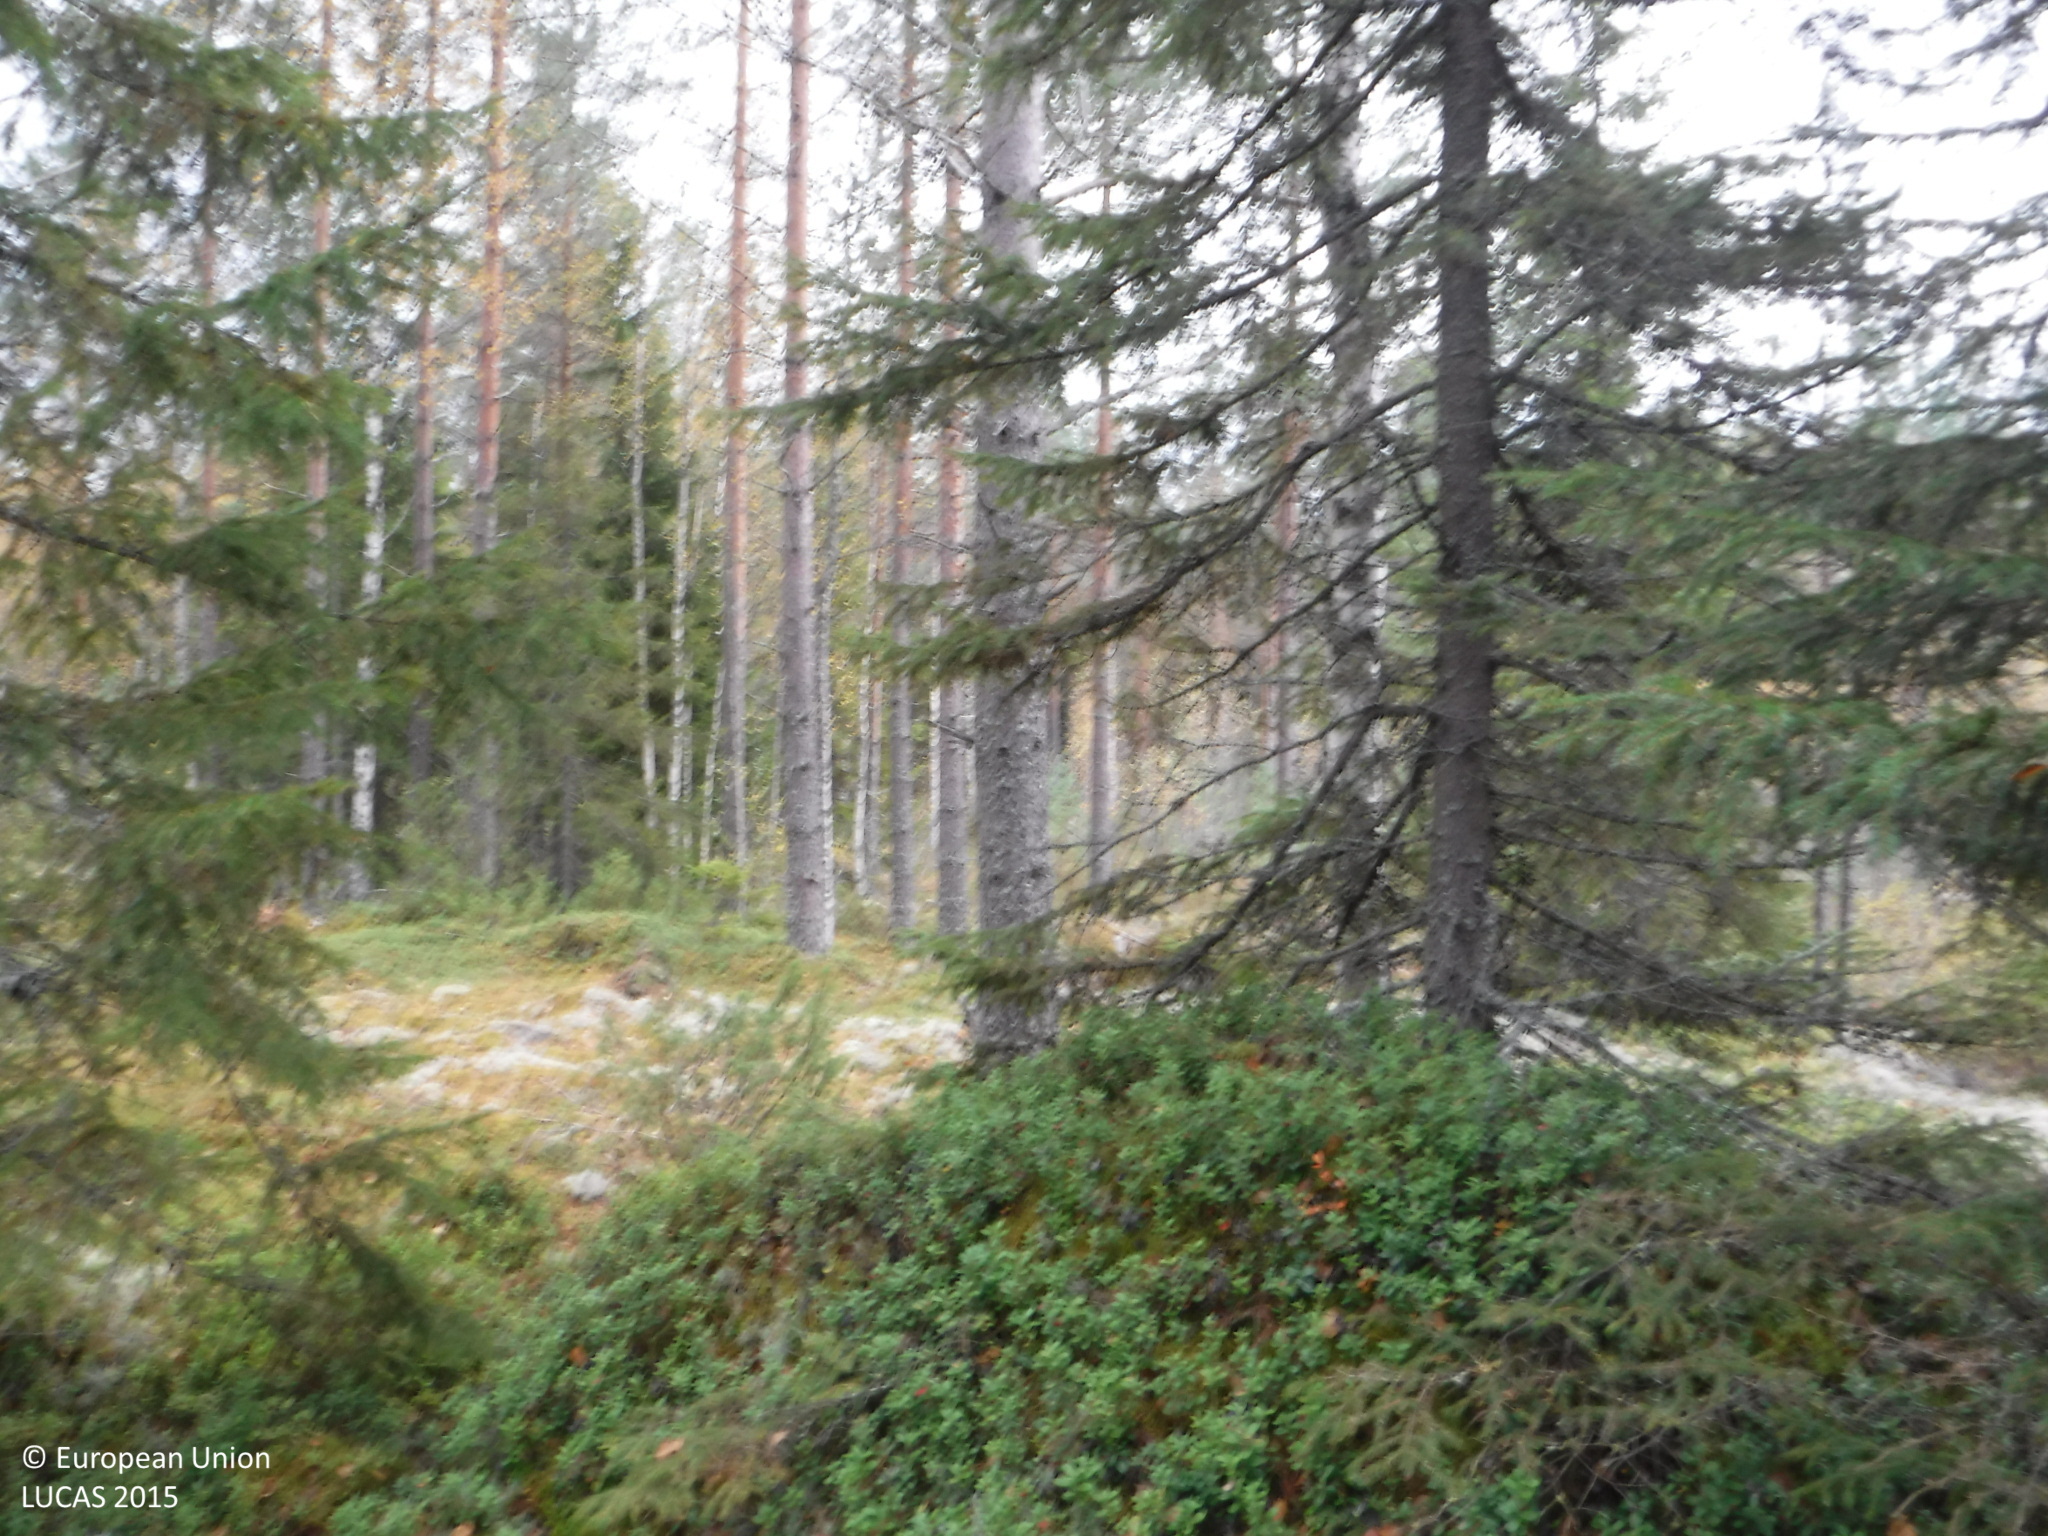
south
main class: Woodland
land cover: Other mixed woodland
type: boreal forest
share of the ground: 50 - 75 %
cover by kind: coniferous forest trees 25 %, broadleaved forest trees 25 %, shrubs 25 %, lichens and mosses 25 %
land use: Forestry
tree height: > 5 m
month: September
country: FI
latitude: 62.0356
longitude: 23.3194
